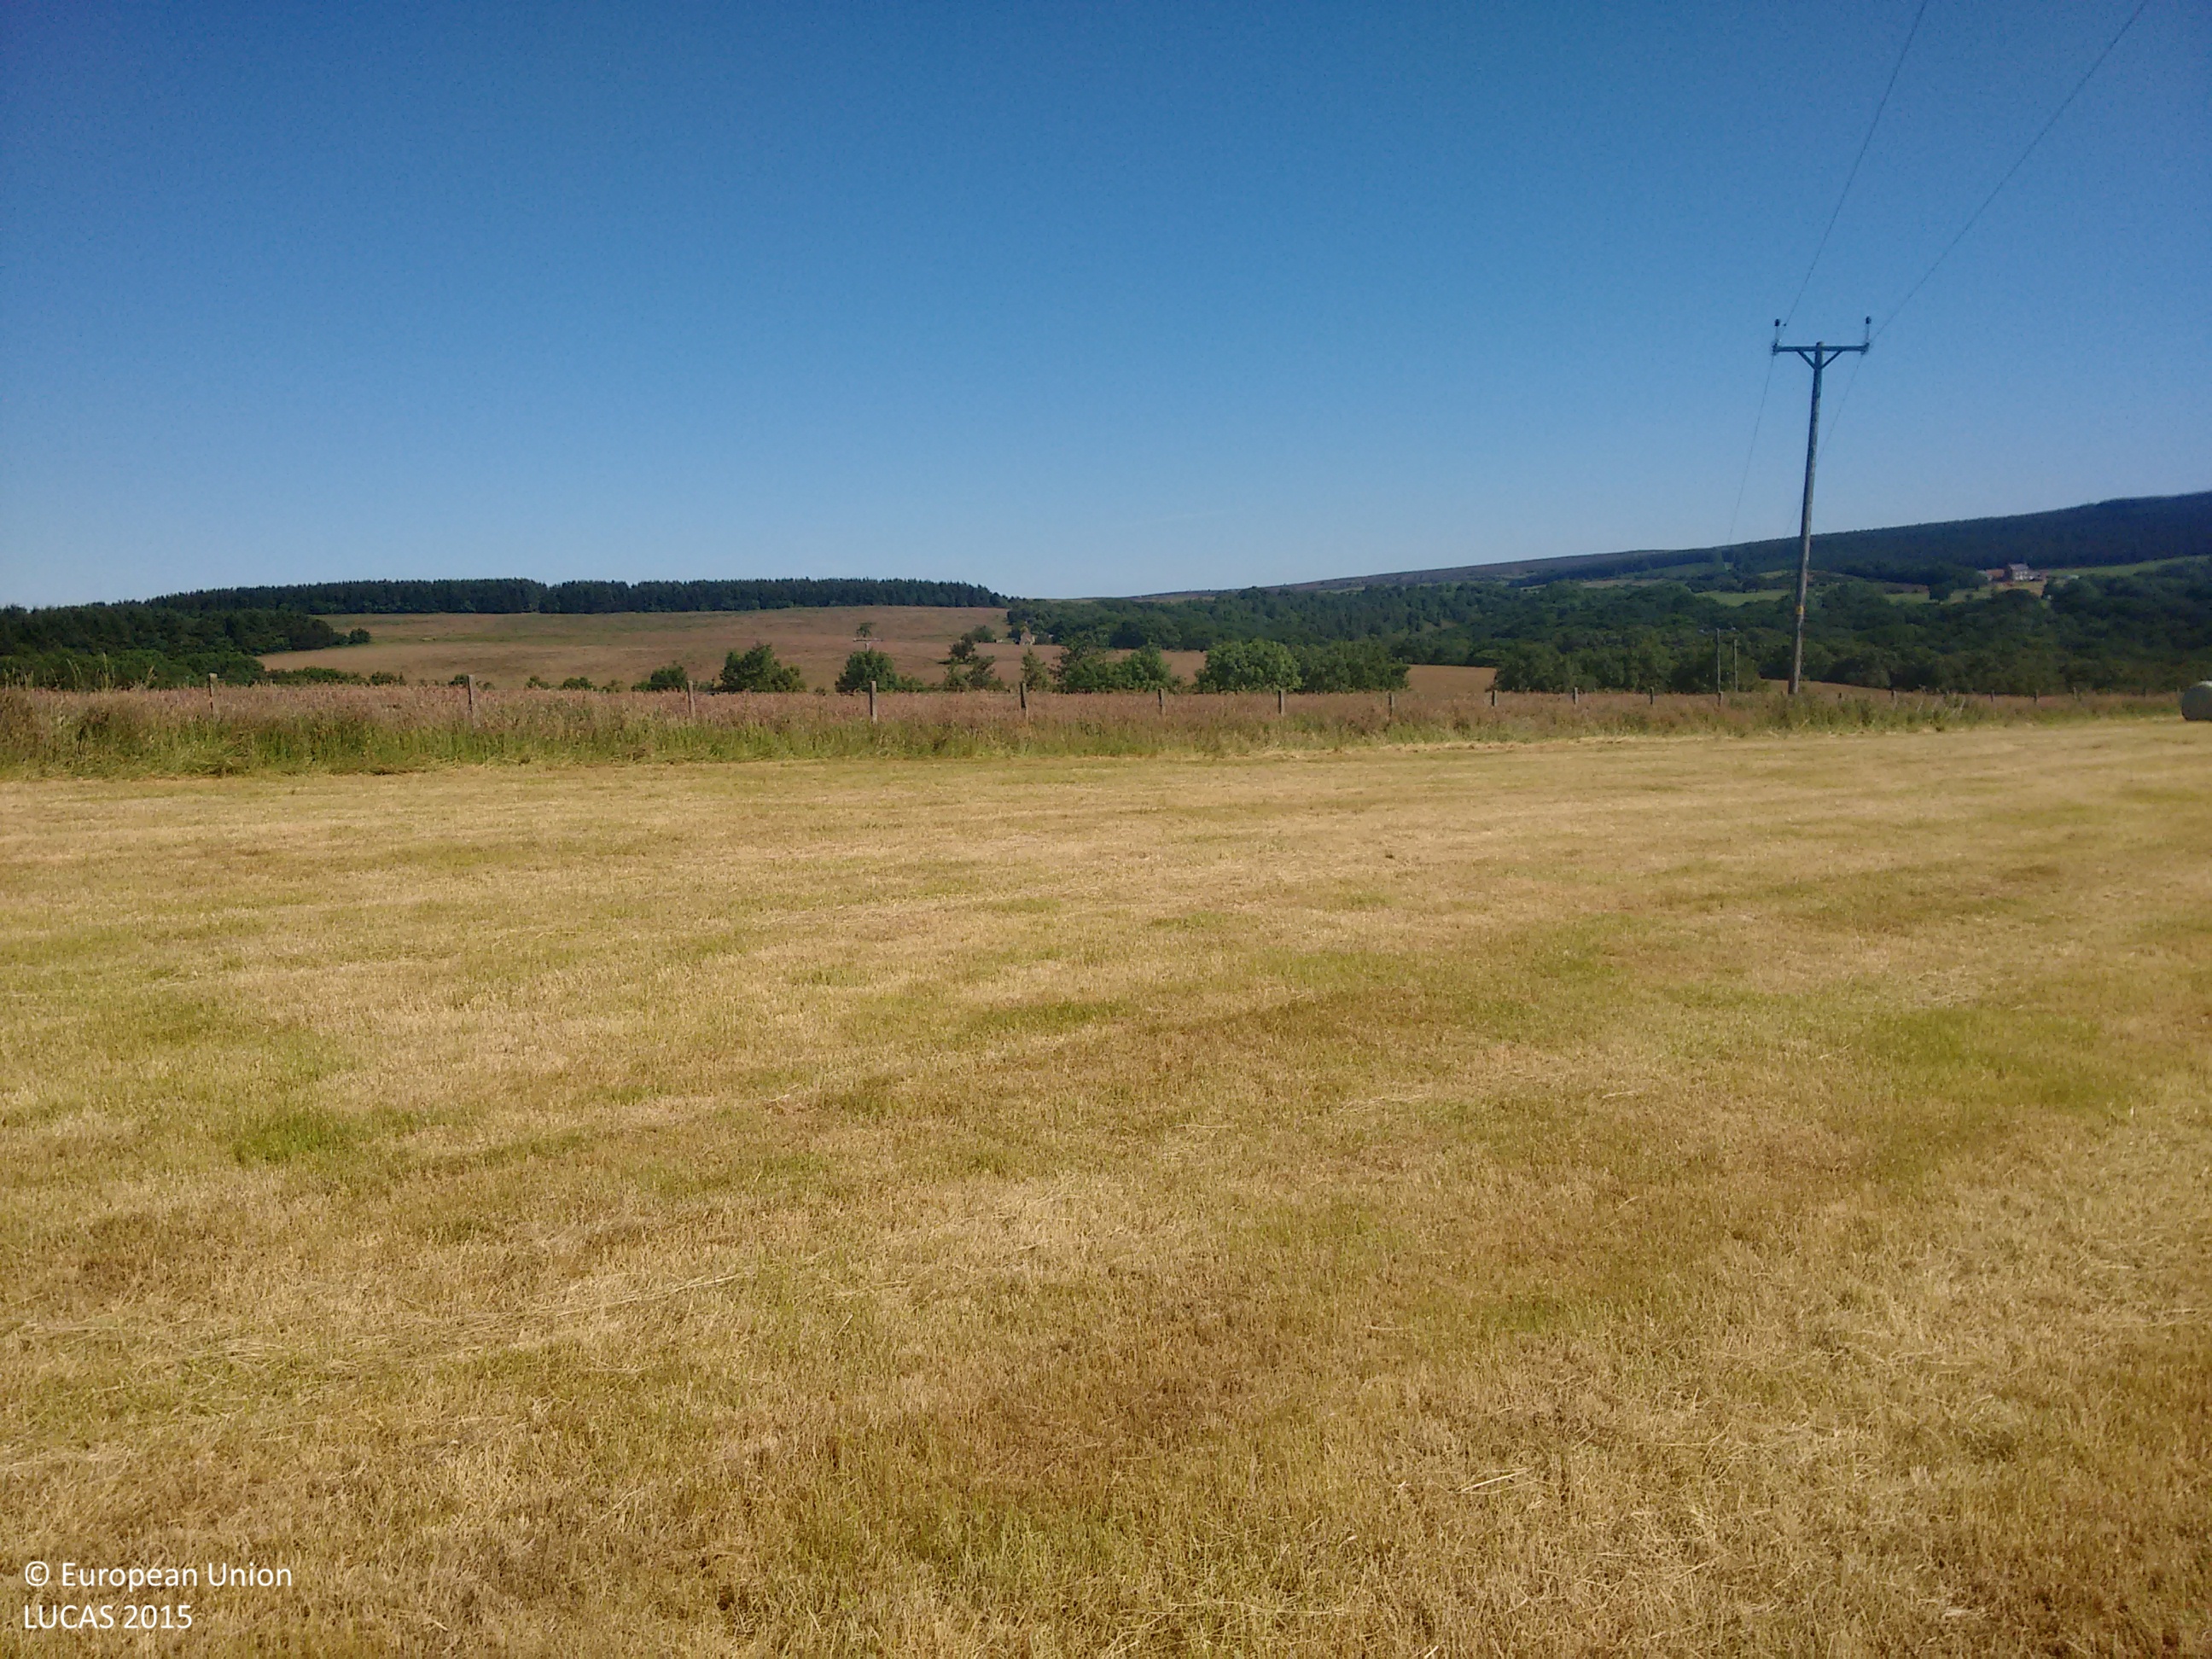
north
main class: Grassland
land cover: Grassland without tree/shrub cover
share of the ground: > 75 %
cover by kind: herbaceous plants 100 %
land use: Agriculture (excluding fallow land and kitchen gardens)
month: July
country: GB
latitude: 54.3549
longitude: -0.5457
